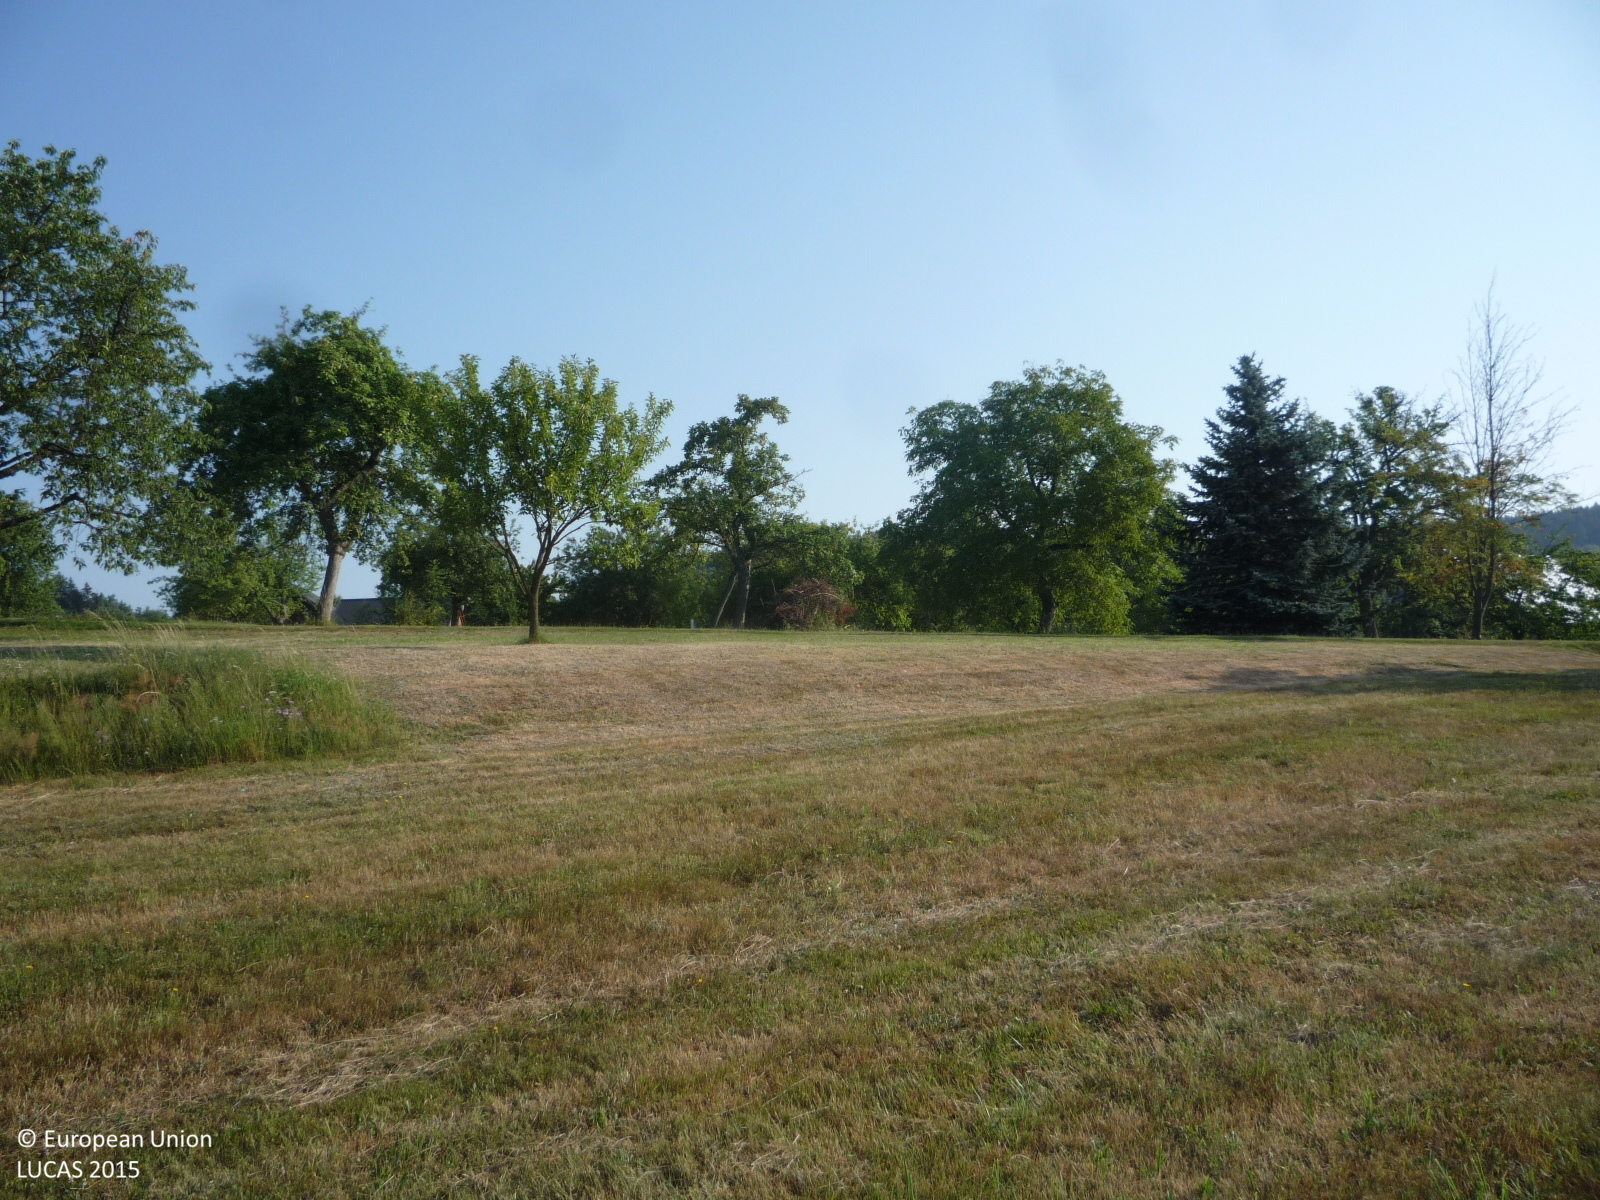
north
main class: Grassland
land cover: Grassland without tree/shrub cover
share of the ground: > 75 %
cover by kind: herbaceous plants 100 %
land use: Agriculture (excluding fallow land and kitchen gardens)
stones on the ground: < 10 %
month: August
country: CZ
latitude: 50.6592
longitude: 15.2233
